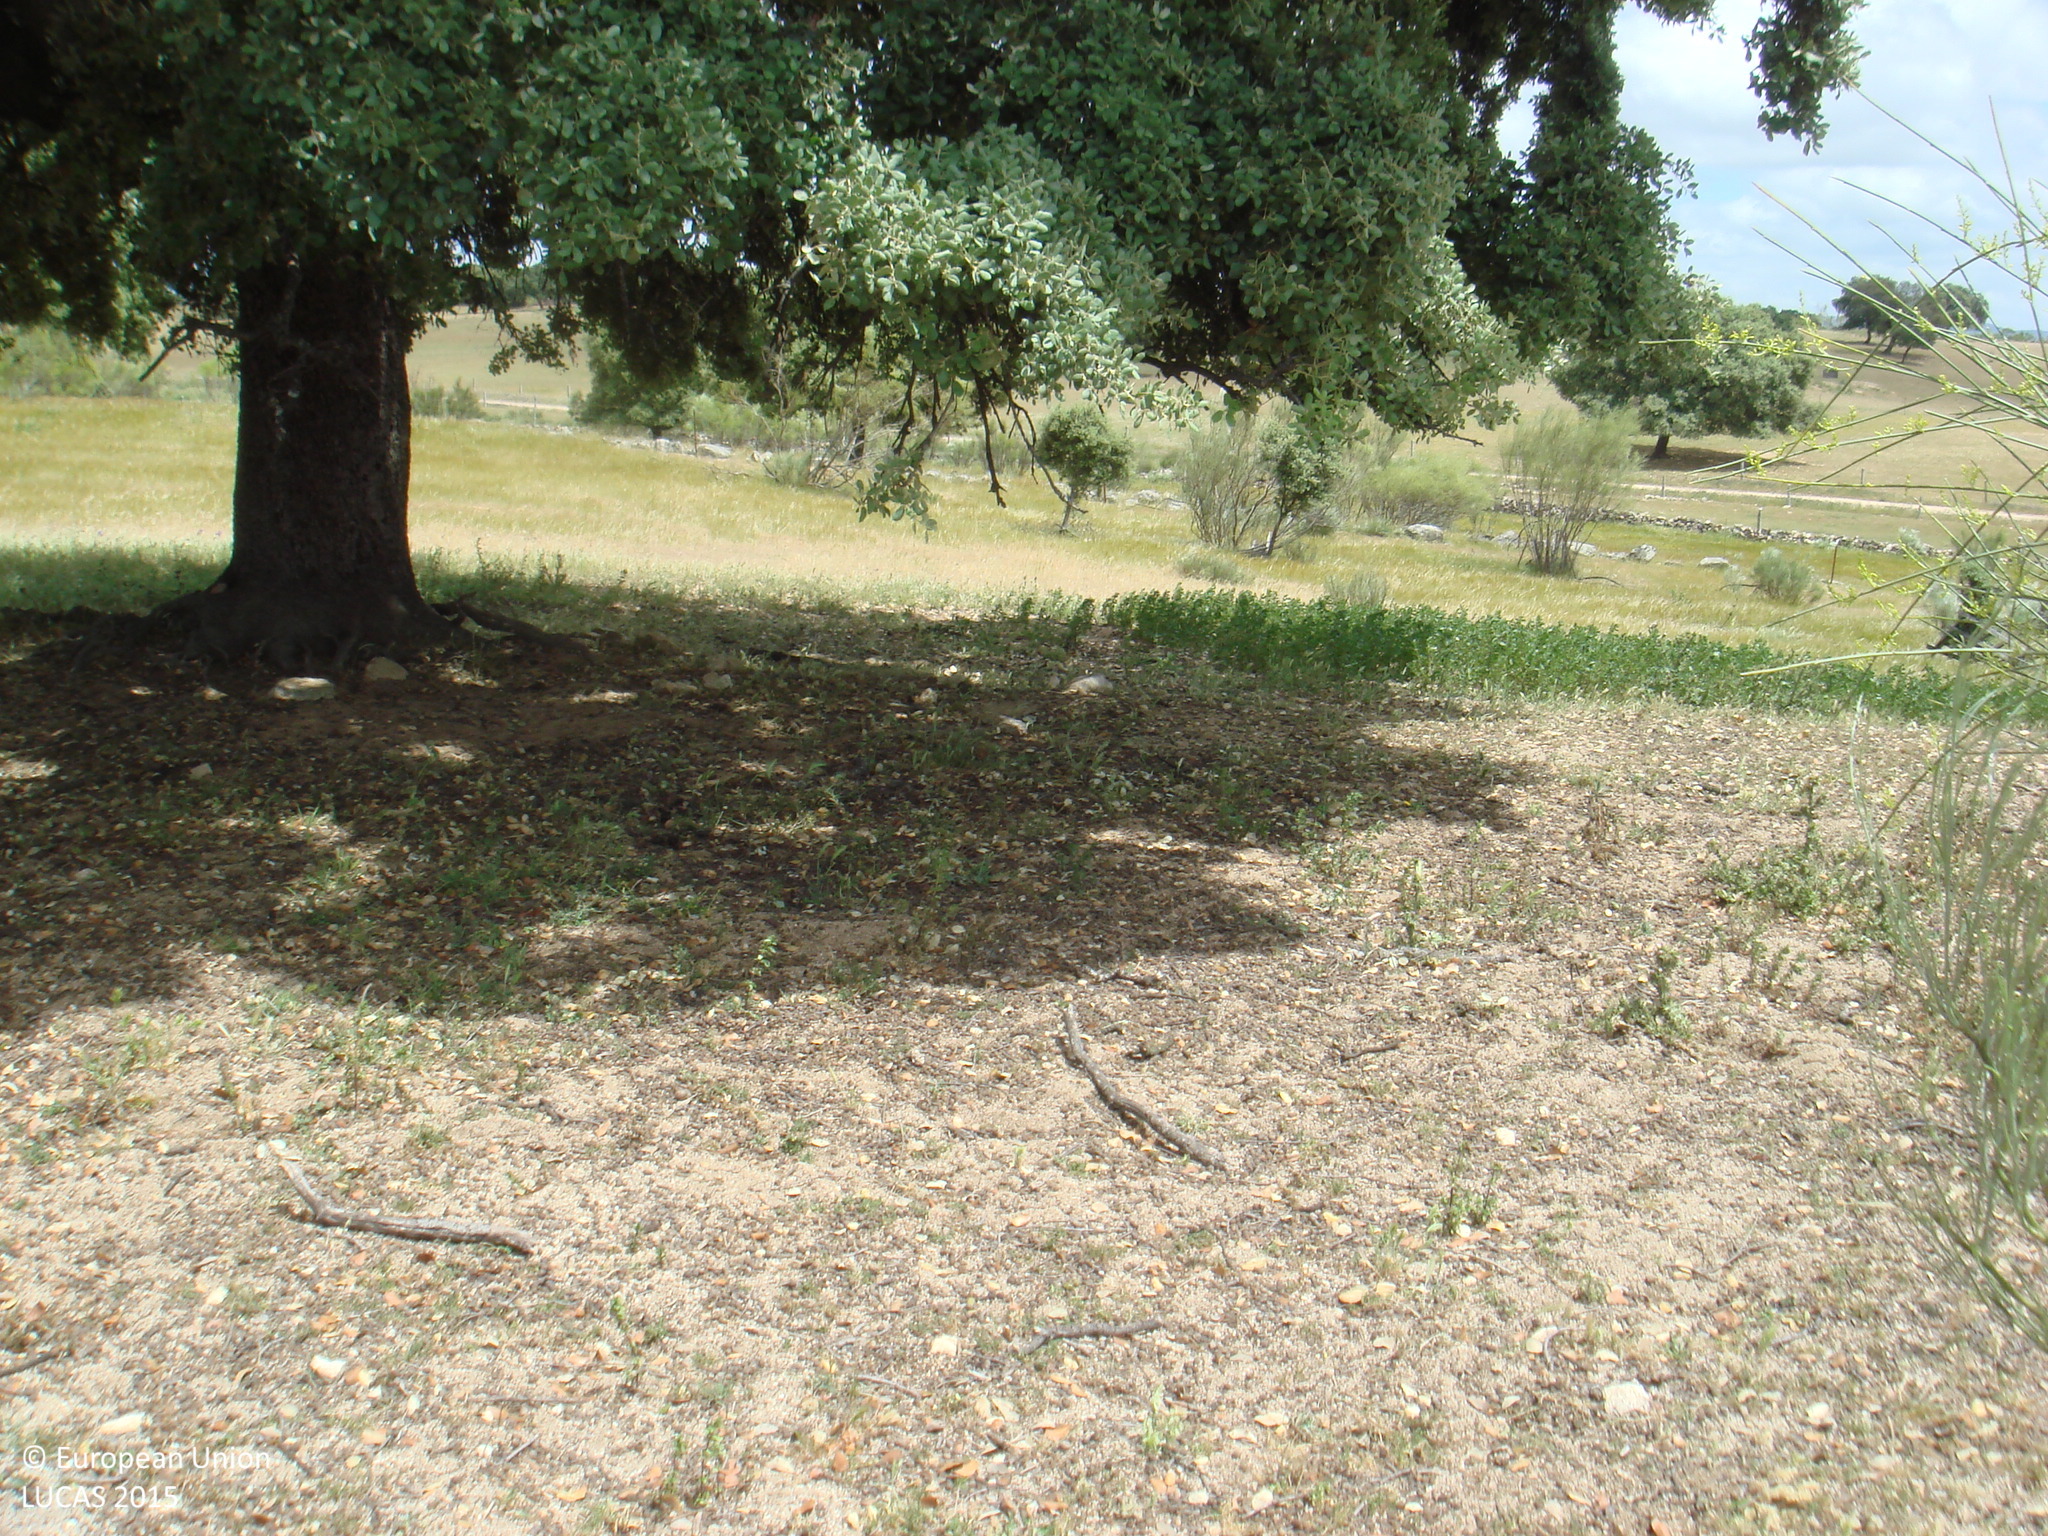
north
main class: Woodland
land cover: Broadleaved woodland
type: broadleaved evergreen forest
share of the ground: 25 - 50 %
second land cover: Shrubland without tree cover
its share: 10 - 25 %
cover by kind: broadleaved forest trees 40 %, herbaceous plants 40 %, shrubs 20 %
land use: Forestry
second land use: Agriculture (excluding fallow land and kitchen gardens)
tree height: > 5 m
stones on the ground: < 10 %
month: May
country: ES
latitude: 38.4408
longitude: -4.6755
